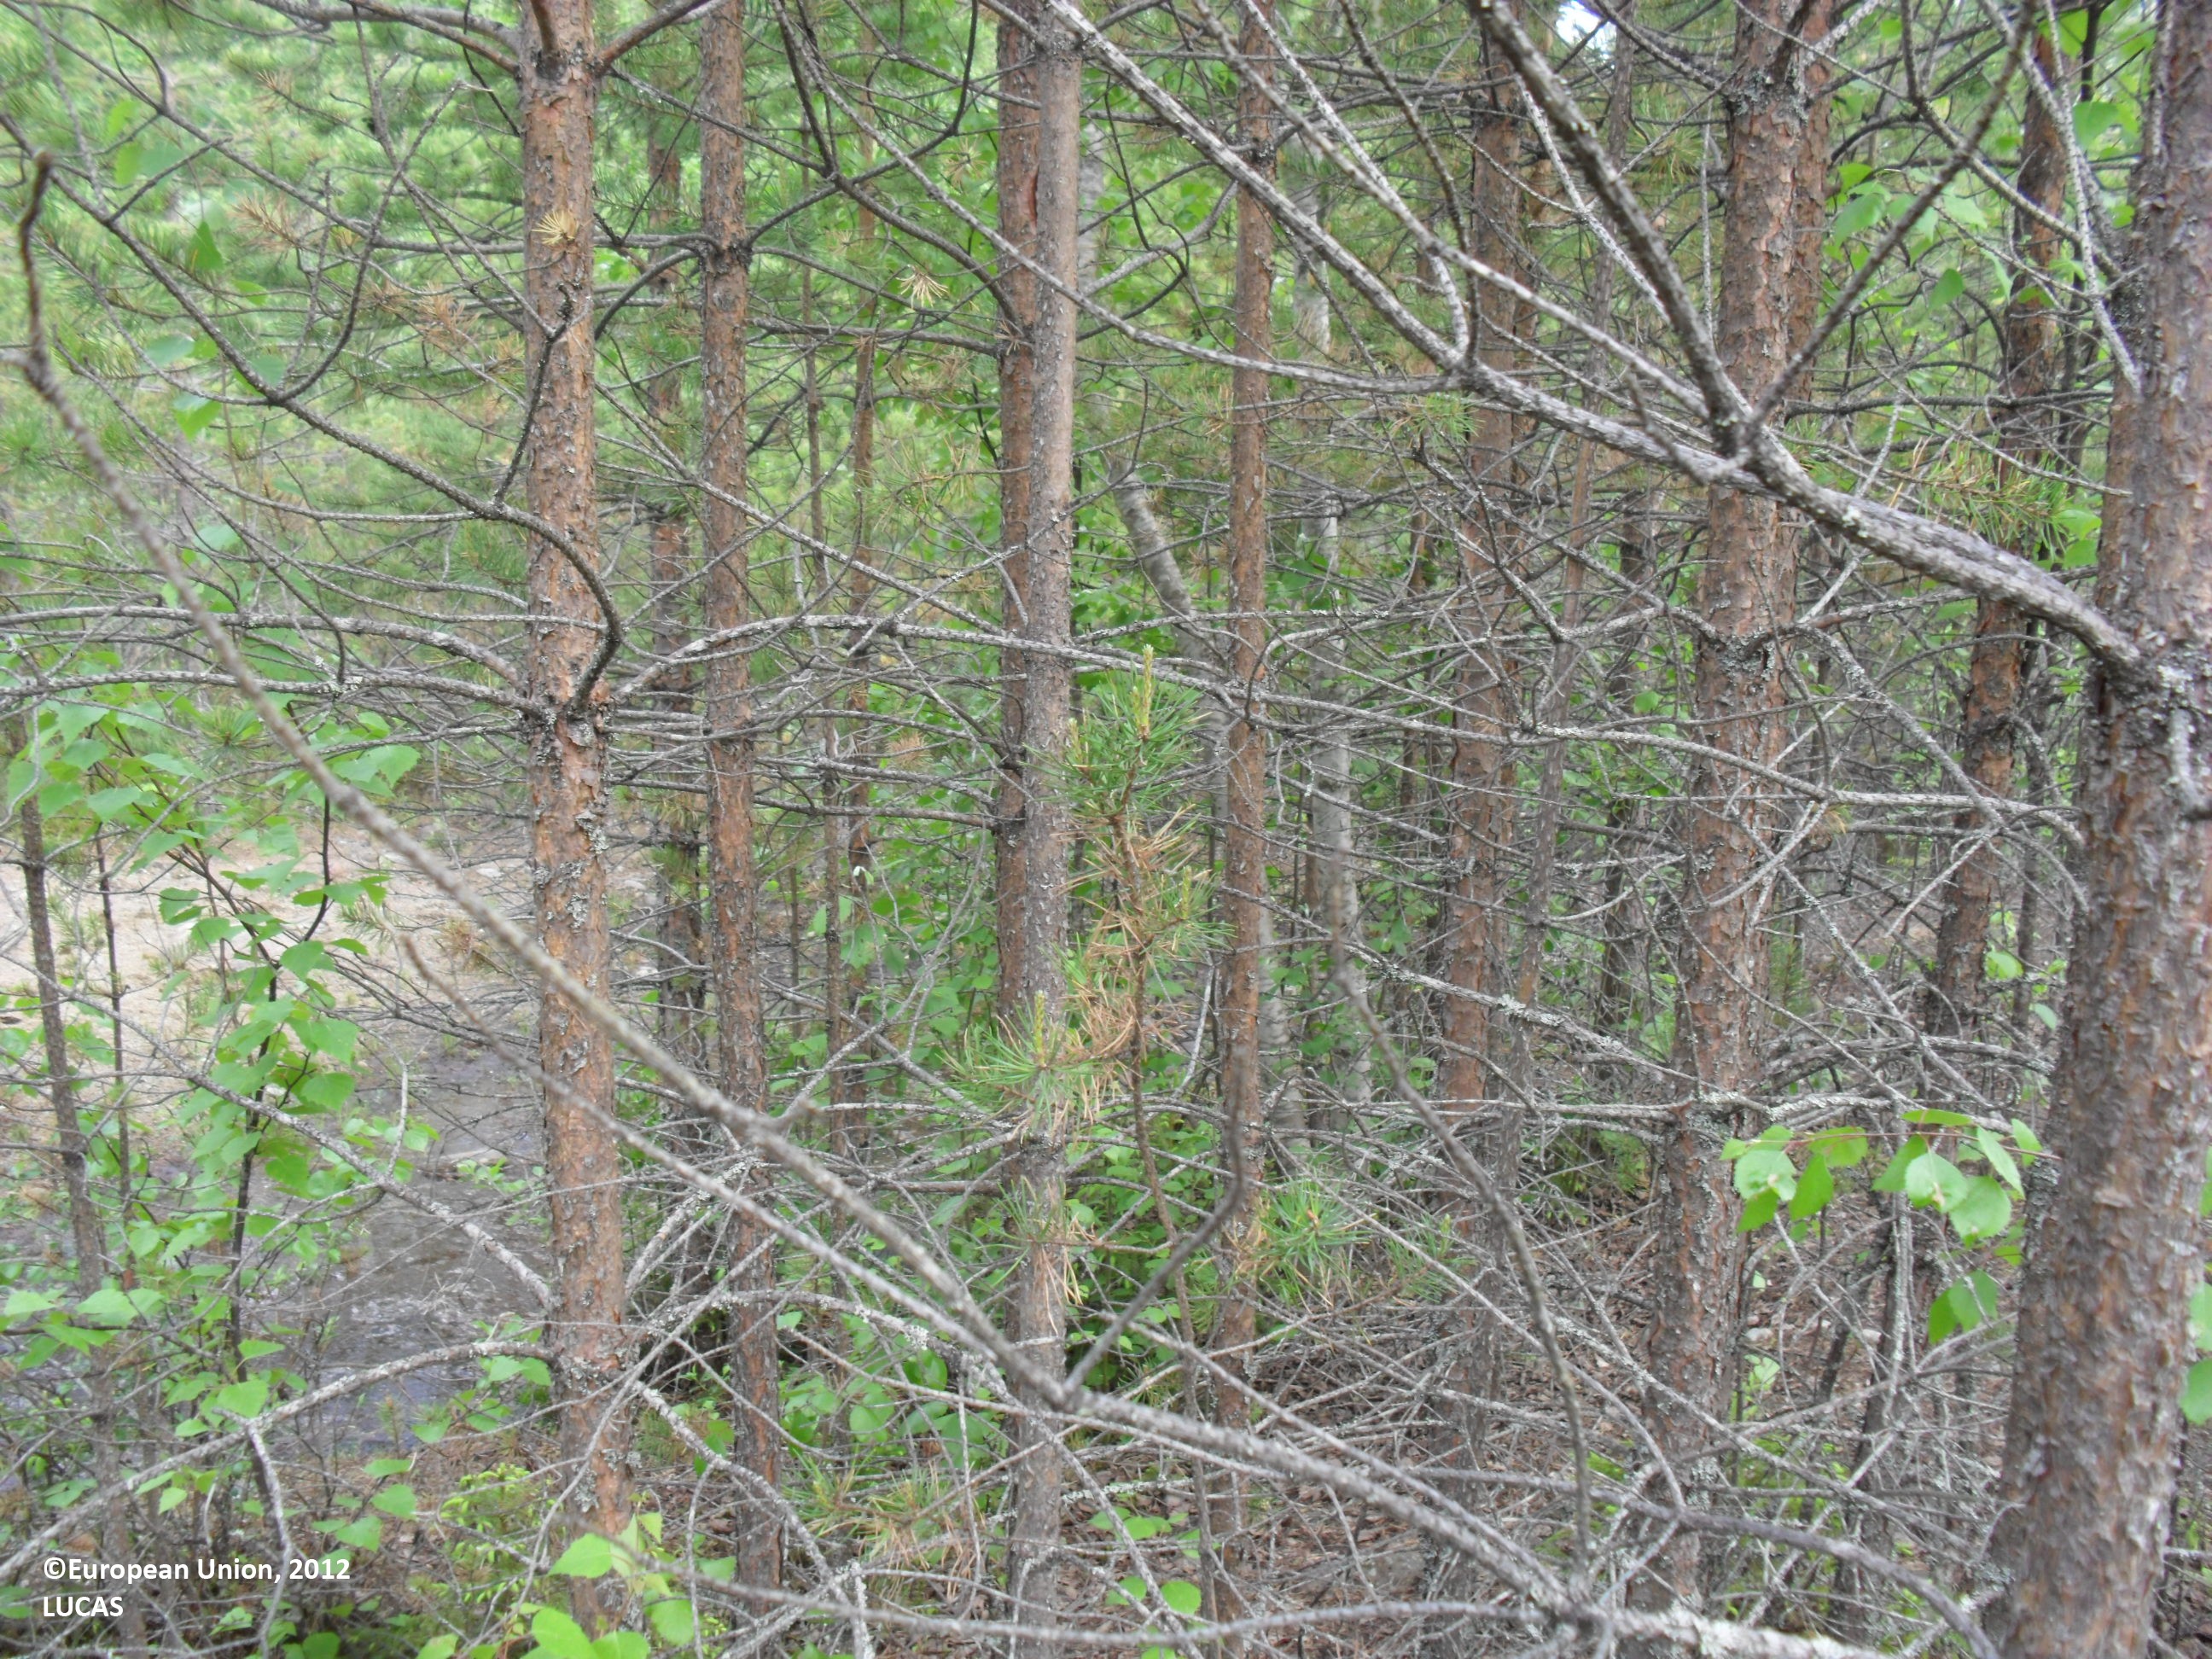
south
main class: Woodland
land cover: Pine dominated coniferous woodland
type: boreal forest
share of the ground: 50 - 75 %
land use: Forestry
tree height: < 5 m
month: June
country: FI
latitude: 63.0440
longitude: 23.7336
